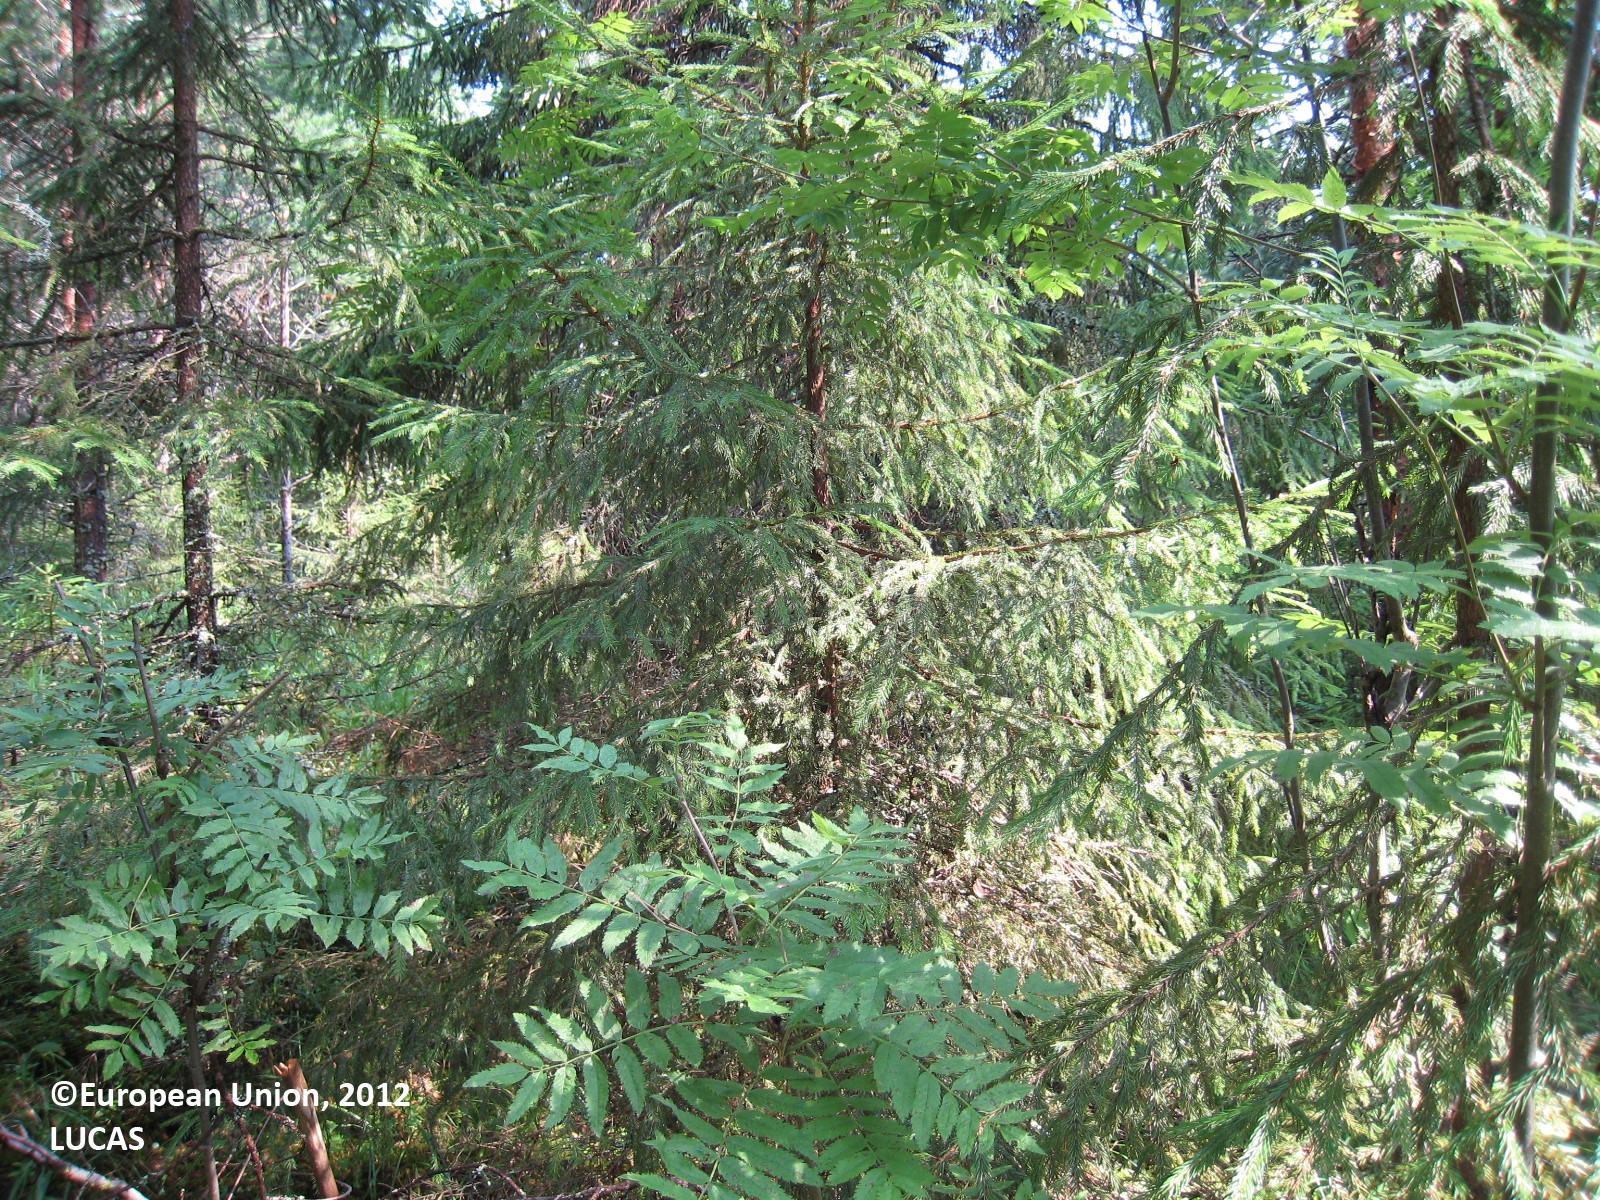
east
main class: Woodland
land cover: Other coniferous woodland
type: boreal forest
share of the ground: > 75 %
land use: Forestry
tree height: > 5 m
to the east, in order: Other coniferous woodland; Other mixed woodland; Spruce dominated mixed woodland; Rivers and streams; Spruce dominated mixed woodland; Other mixed woodland; Pine dominated coniferous woodland
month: July
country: FI
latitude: 62.4588
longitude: 27.3985
